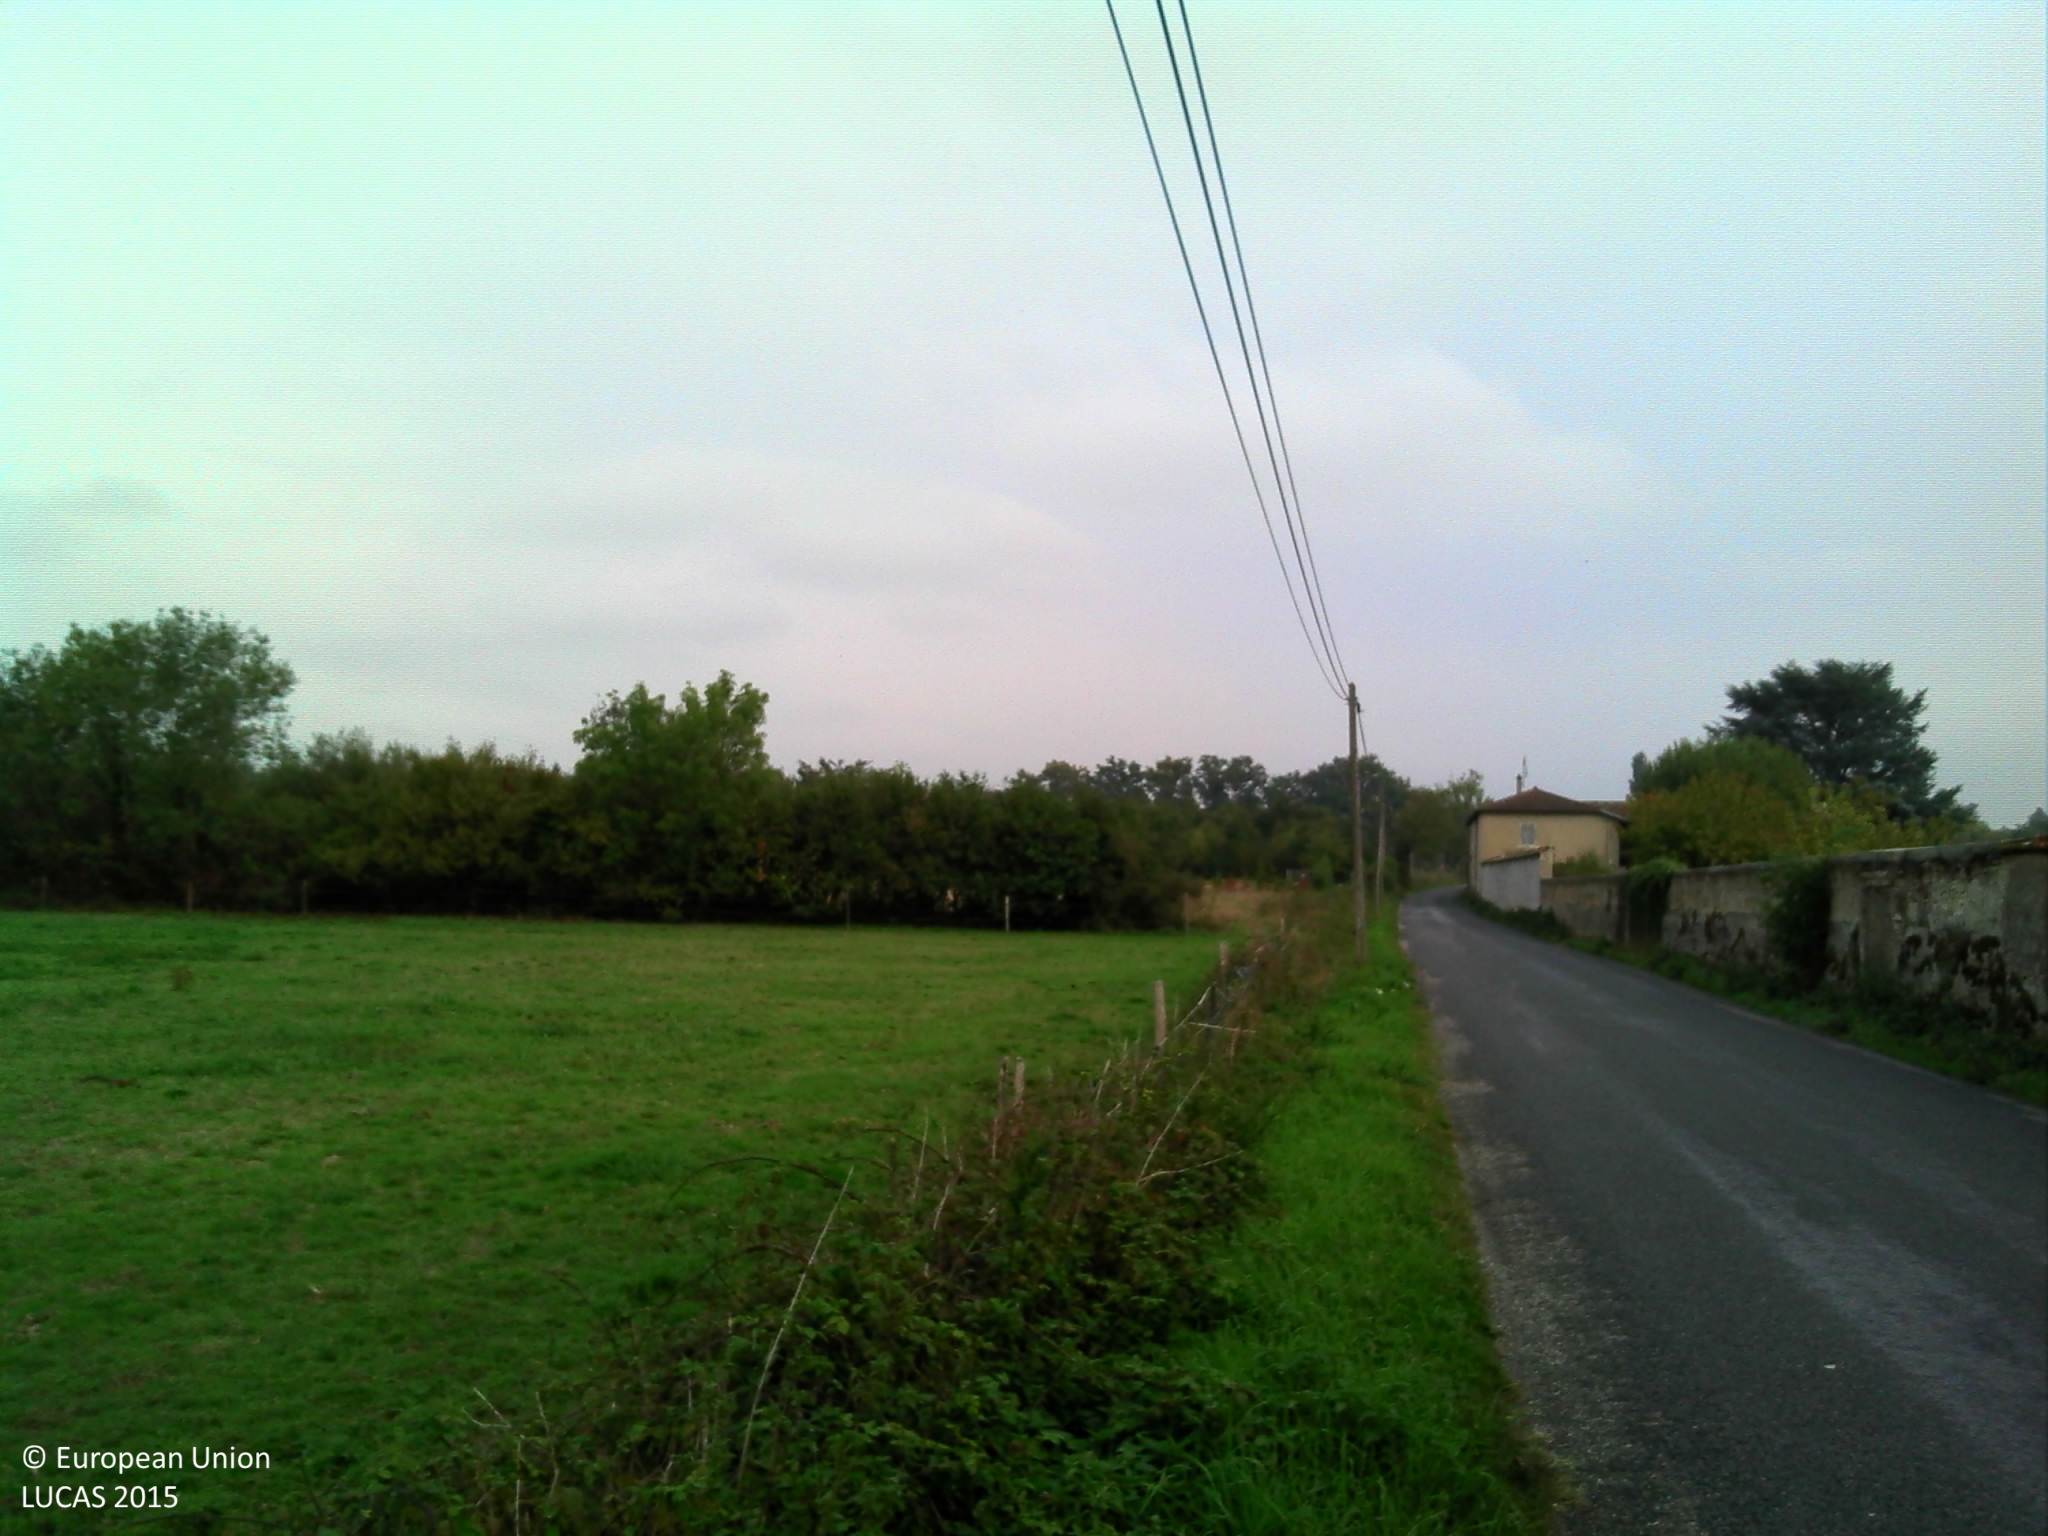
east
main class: Grassland
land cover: Grassland without tree/shrub cover
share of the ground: > 75 %
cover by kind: herbaceous plants 100 %
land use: Agriculture (excluding fallow land and kitchen gardens)
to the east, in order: Grassland without tree/shrub cover; Fences; Broadleaved woodland; Spontaneously vegetated surfaces; Grassland without tree/shrub cover; Conifer hedges; Tracks; Electric lines; Managed hedges; Grassland without tree/shrub cover
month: October
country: FR
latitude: 46.1710
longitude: 4.8087
